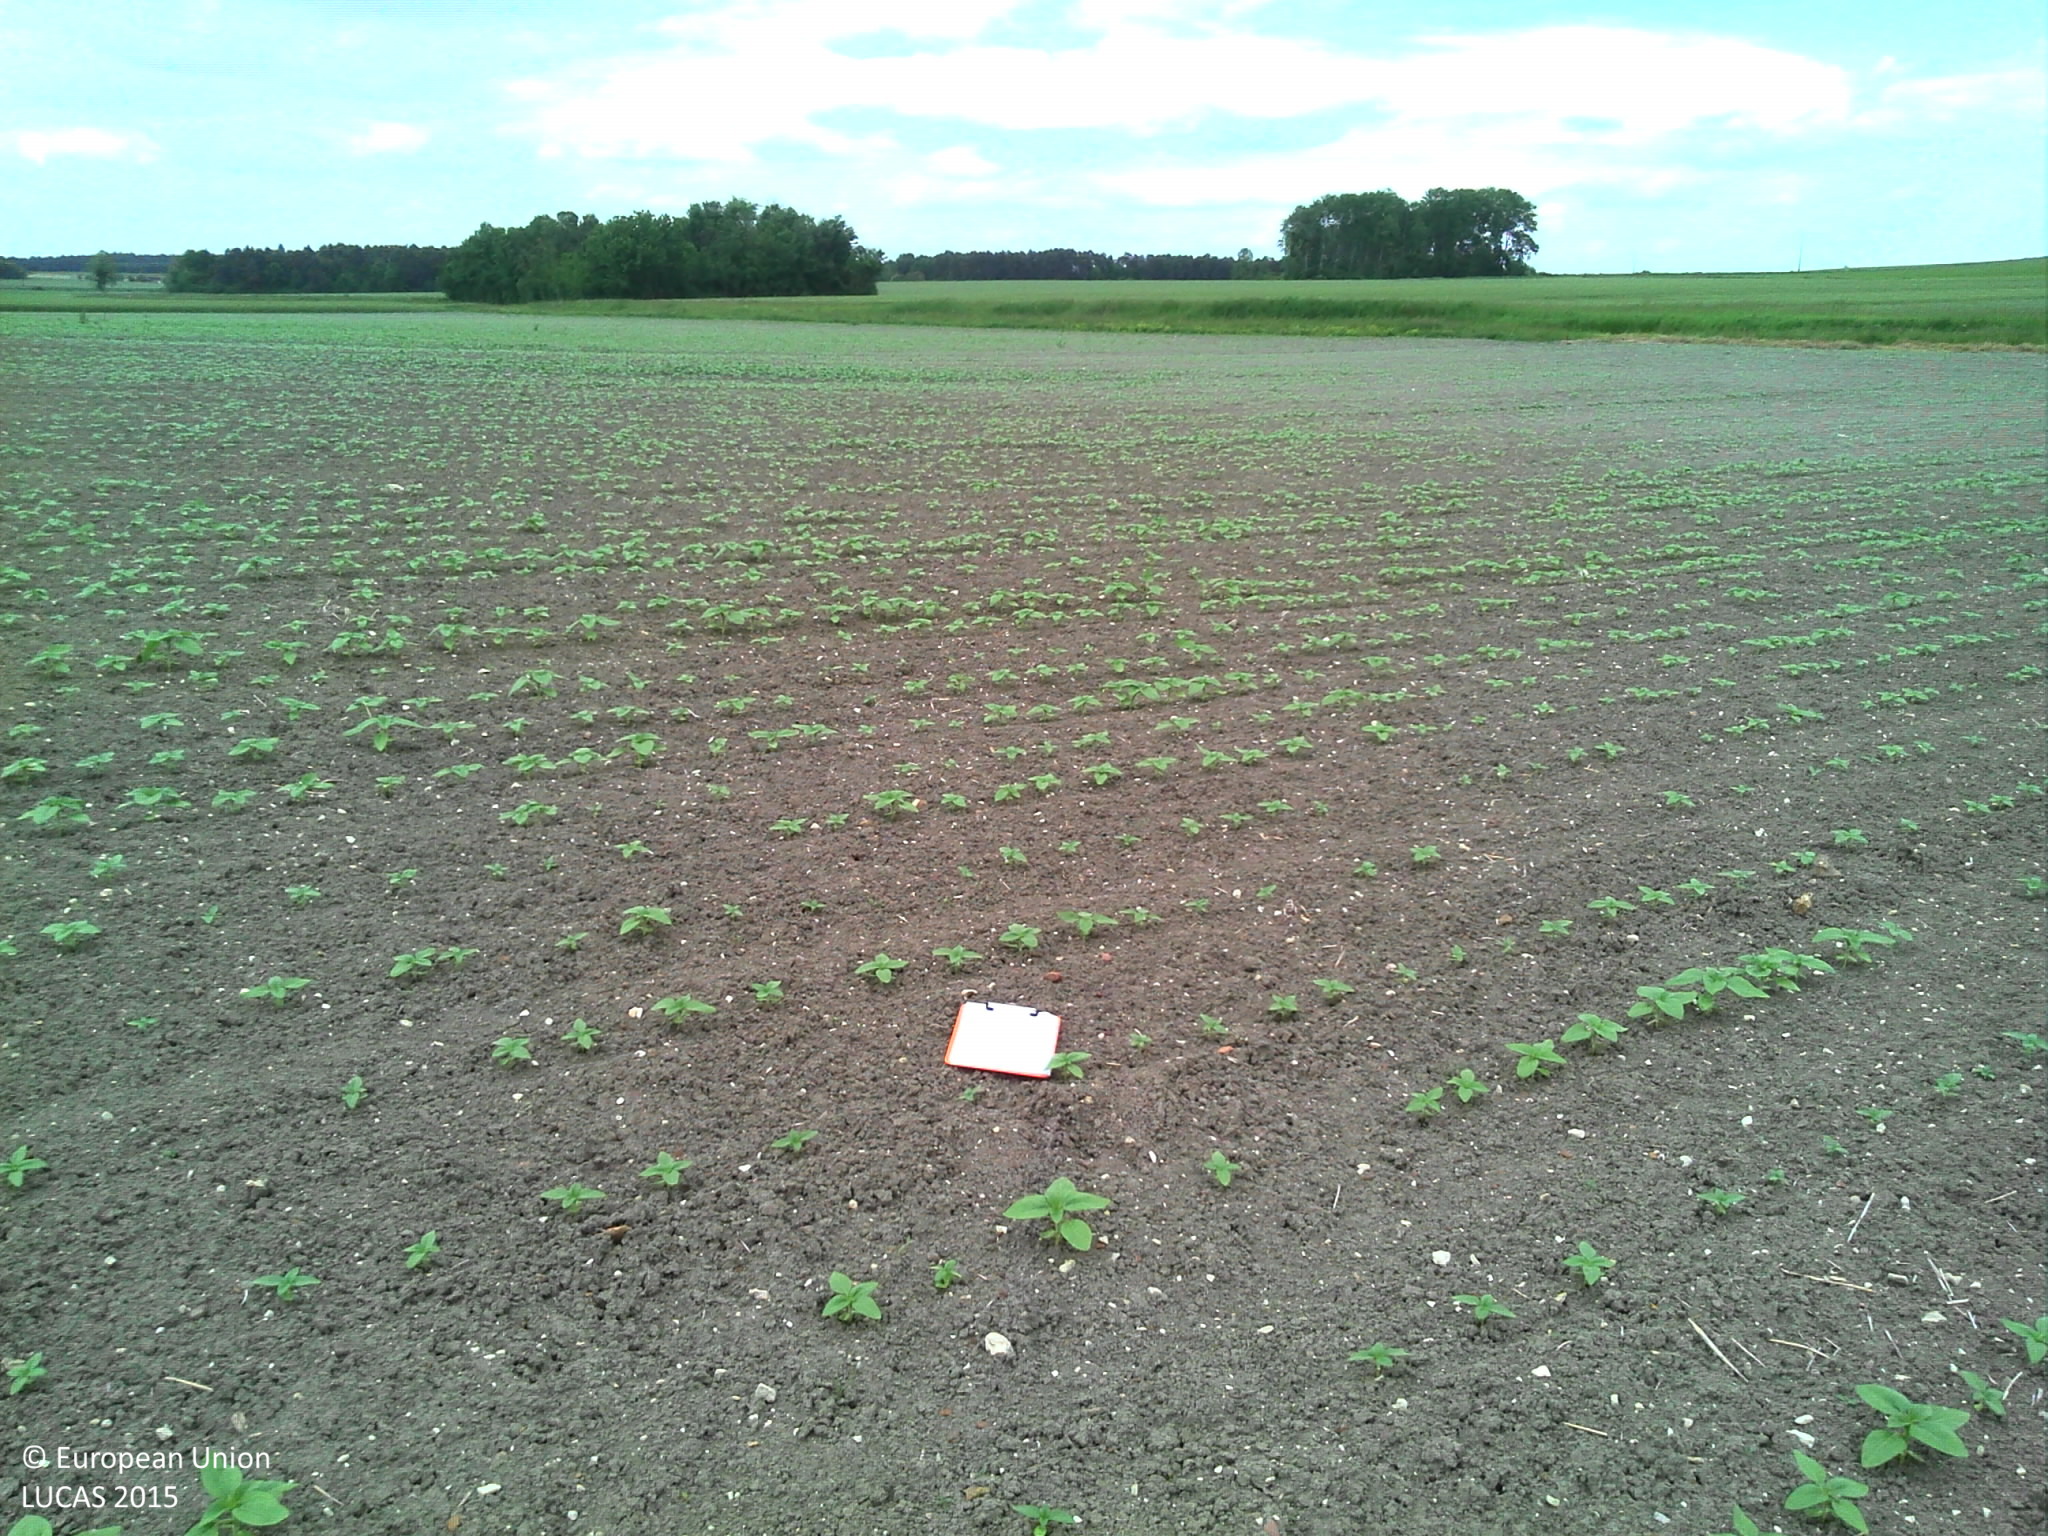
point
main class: Cropland
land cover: Sunflower
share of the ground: 10 - 25 %
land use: Agriculture (excluding fallow land and kitchen gardens)
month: May
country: FR
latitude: 46.7929
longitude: 0.2454
